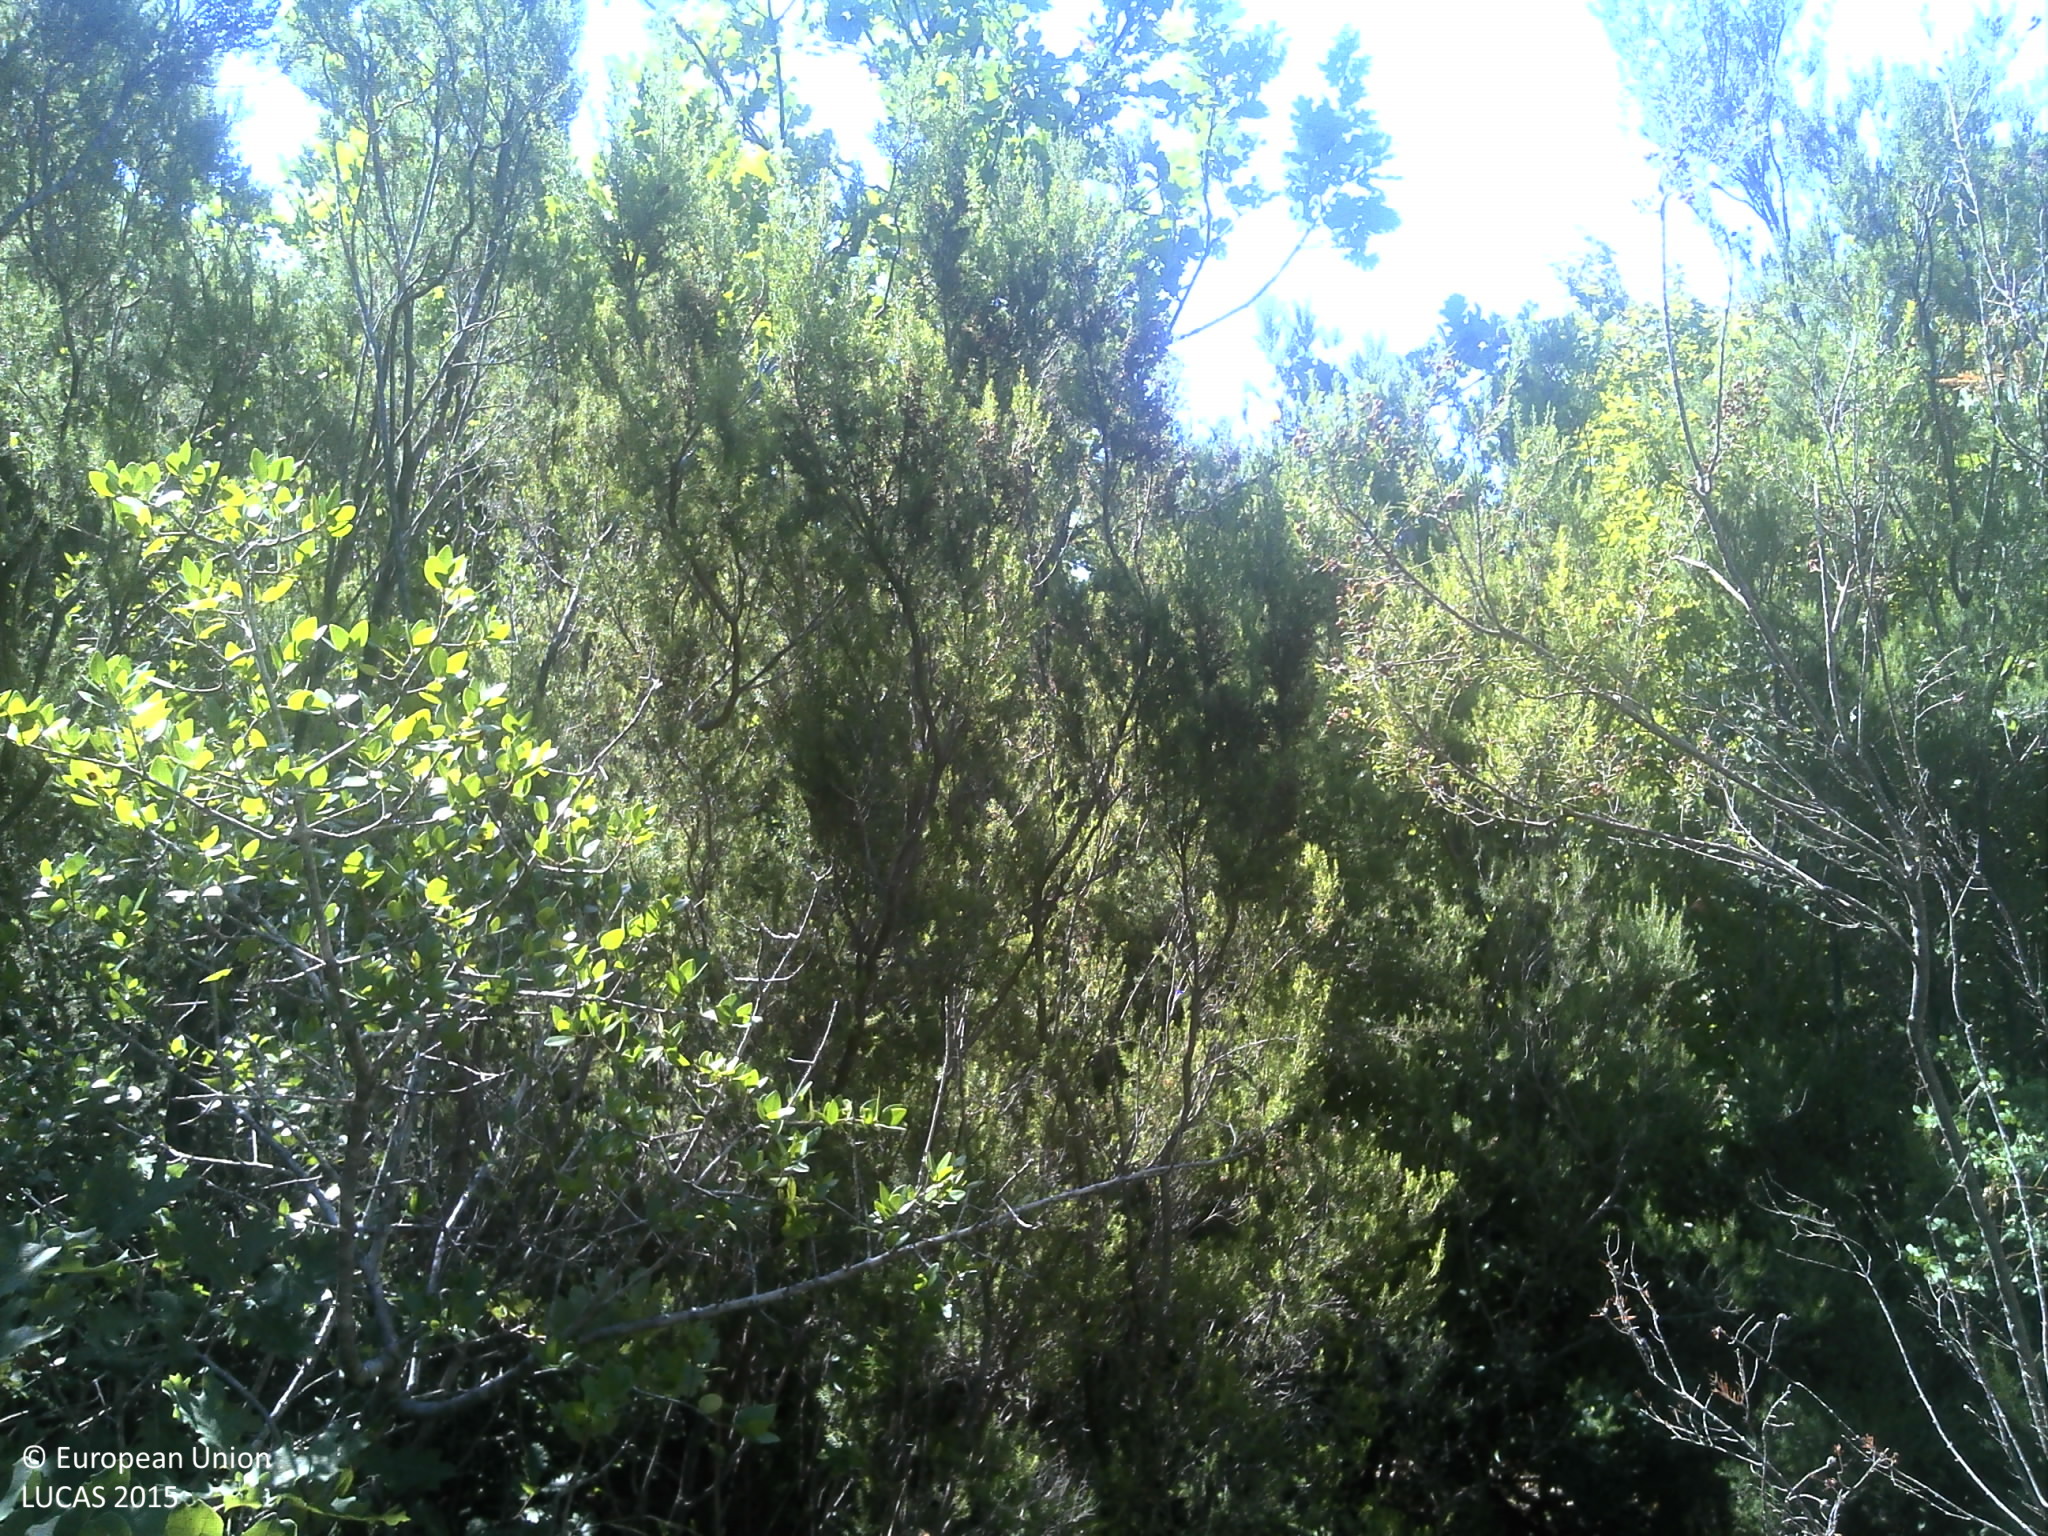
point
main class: Woodland
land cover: Broadleaved woodland
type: thermophilous deciduous forest
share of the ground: > 75 %
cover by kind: shrubs 65 %, broadleaved forest trees 20 %, unconsolidated bare surface 10 %, coniferous forest trees 5 %
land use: Semi-natural and natural areas not in use
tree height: > 5 m
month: August
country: HR
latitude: 43.9164
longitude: 15.4834
